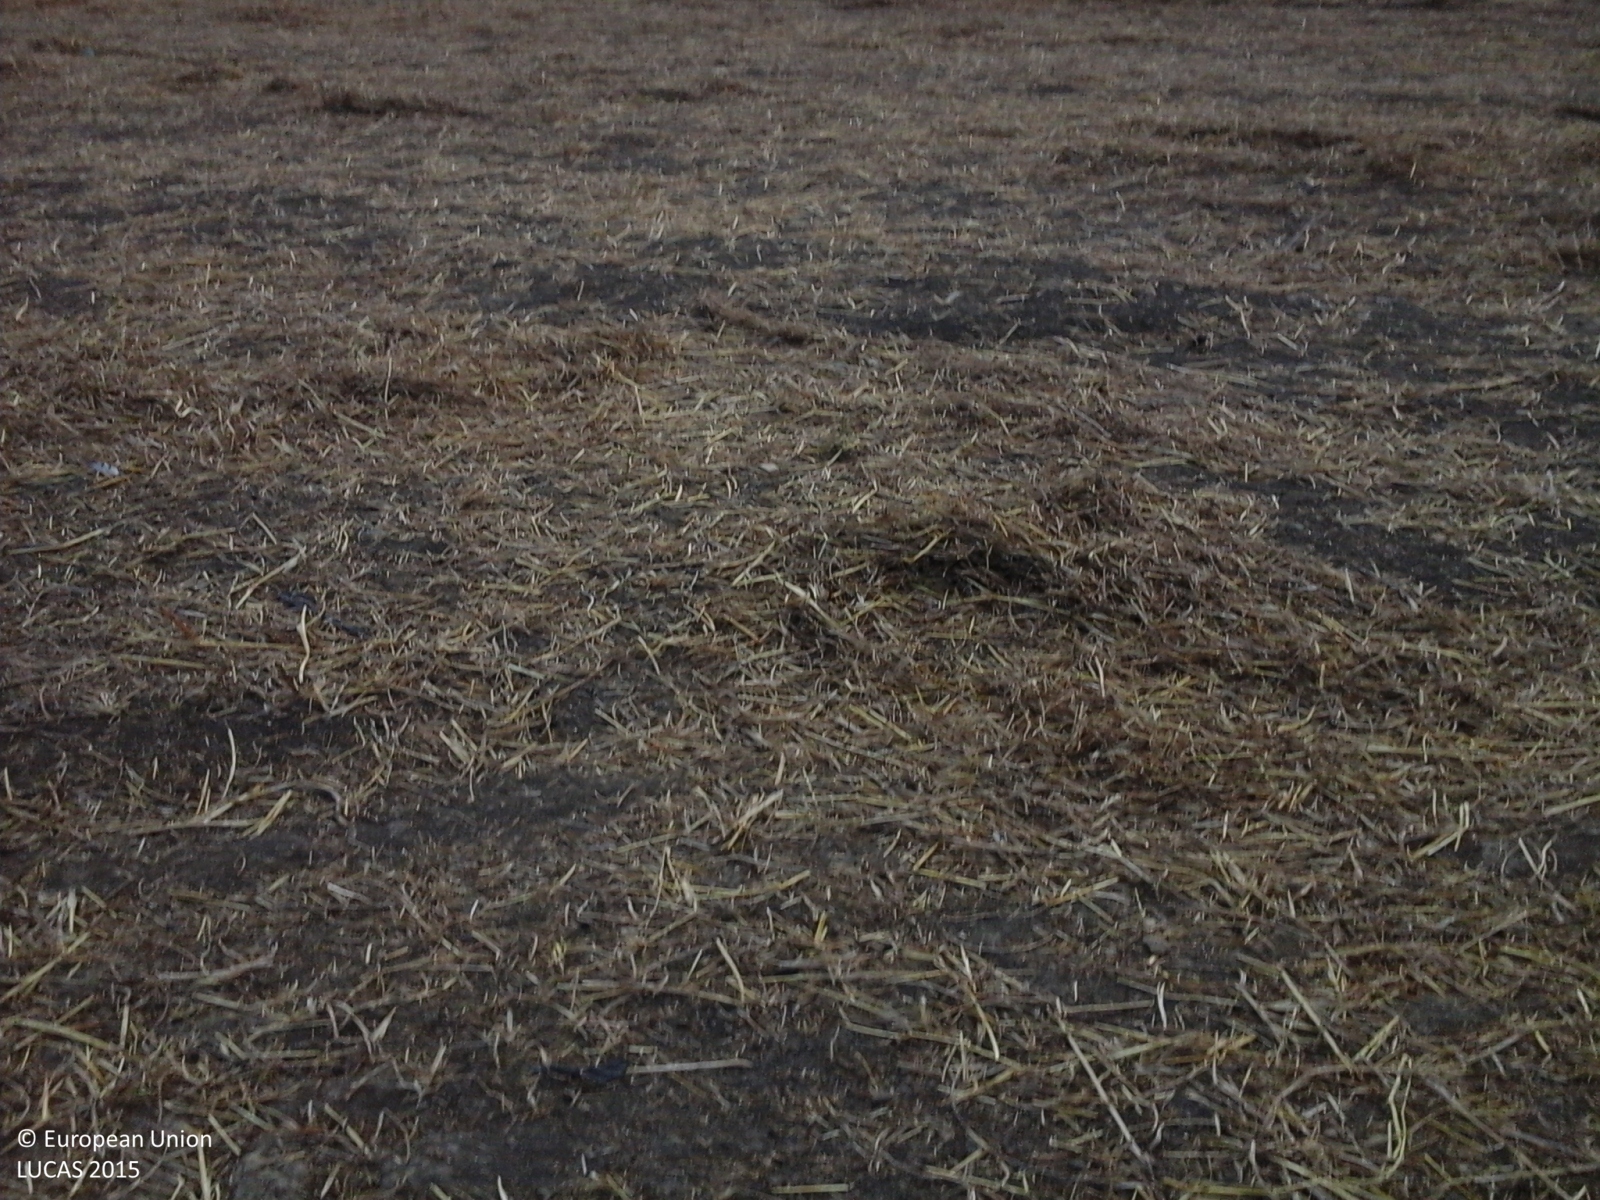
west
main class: Cropland
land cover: Temporary grasslands
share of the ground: 10 - 25 %
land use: Agriculture (excluding fallow land and kitchen gardens)
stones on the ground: < 10 %
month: July
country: IT
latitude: 37.3265
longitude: 14.2224
